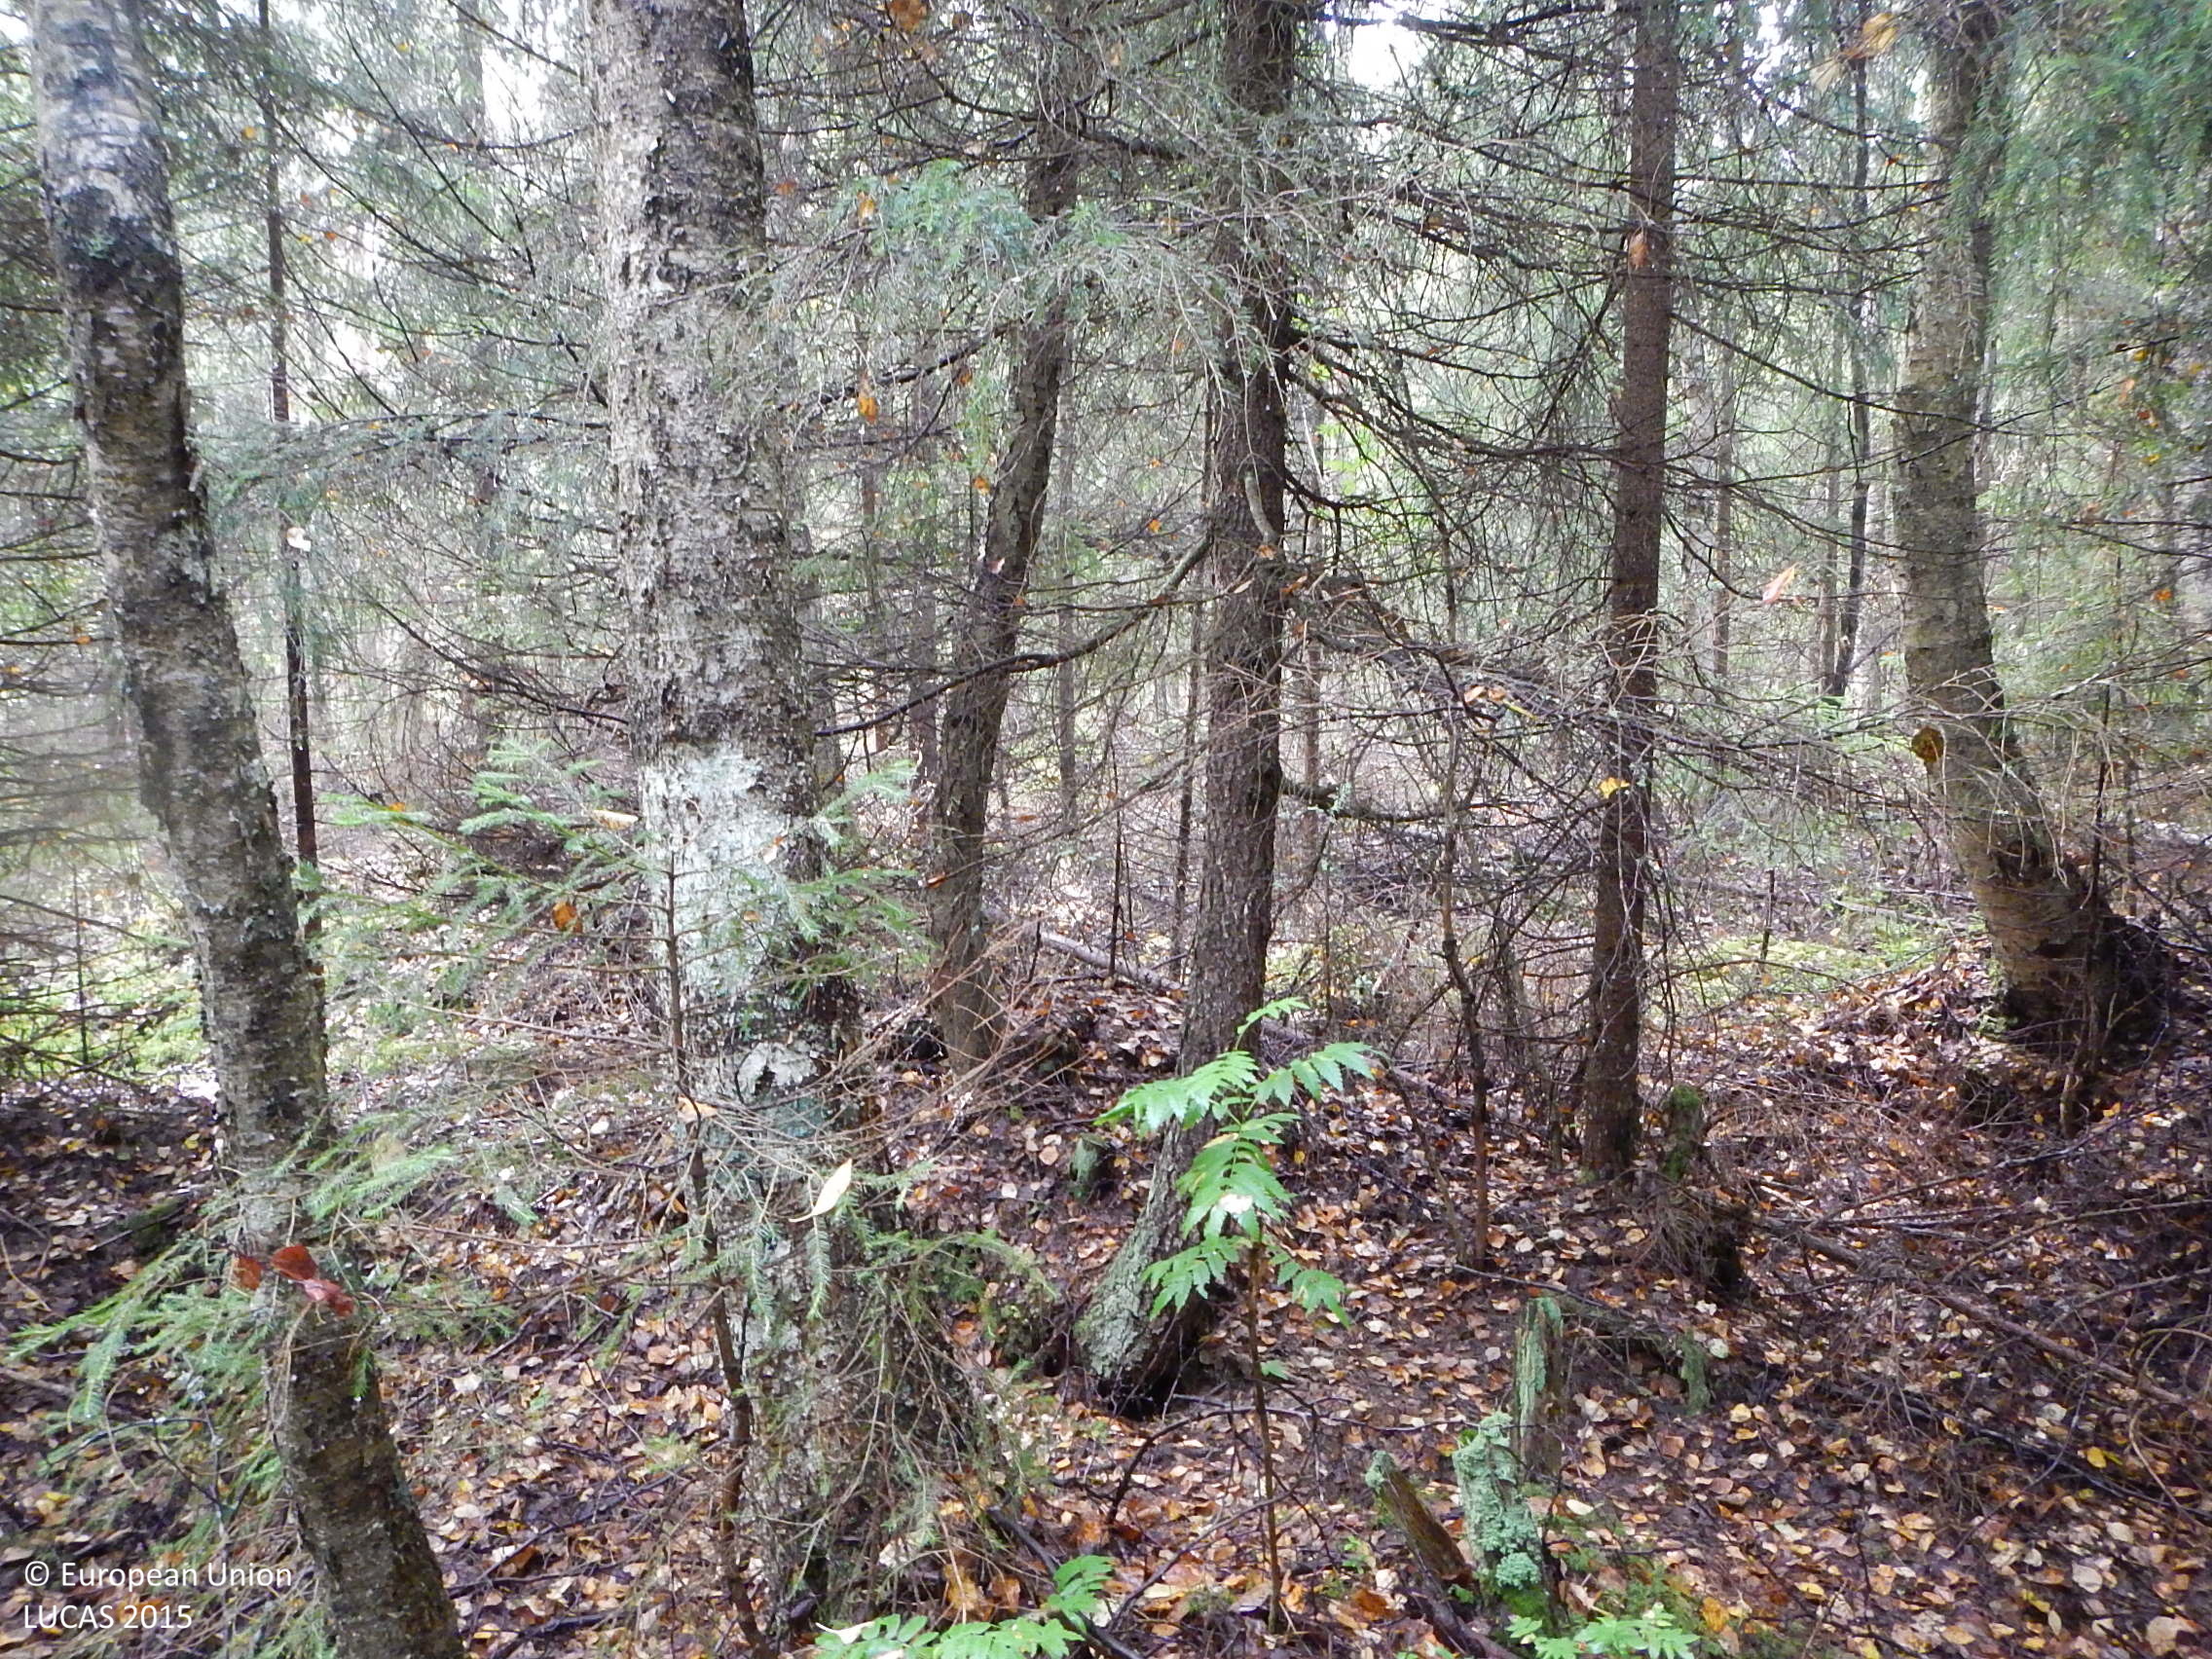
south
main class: Woodland
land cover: Other mixed woodland
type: boreal forest
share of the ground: > 75 %
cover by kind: coniferous forest trees 50 %, broadleaved forest trees 25 %, shrubs 10 %, unconsolidated bare surface 10 %, lichens and mosses 5 %
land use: Forestry
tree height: > 5 m
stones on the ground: 10 - 25 %
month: September
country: FI
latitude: 61.4148
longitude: 22.2575
